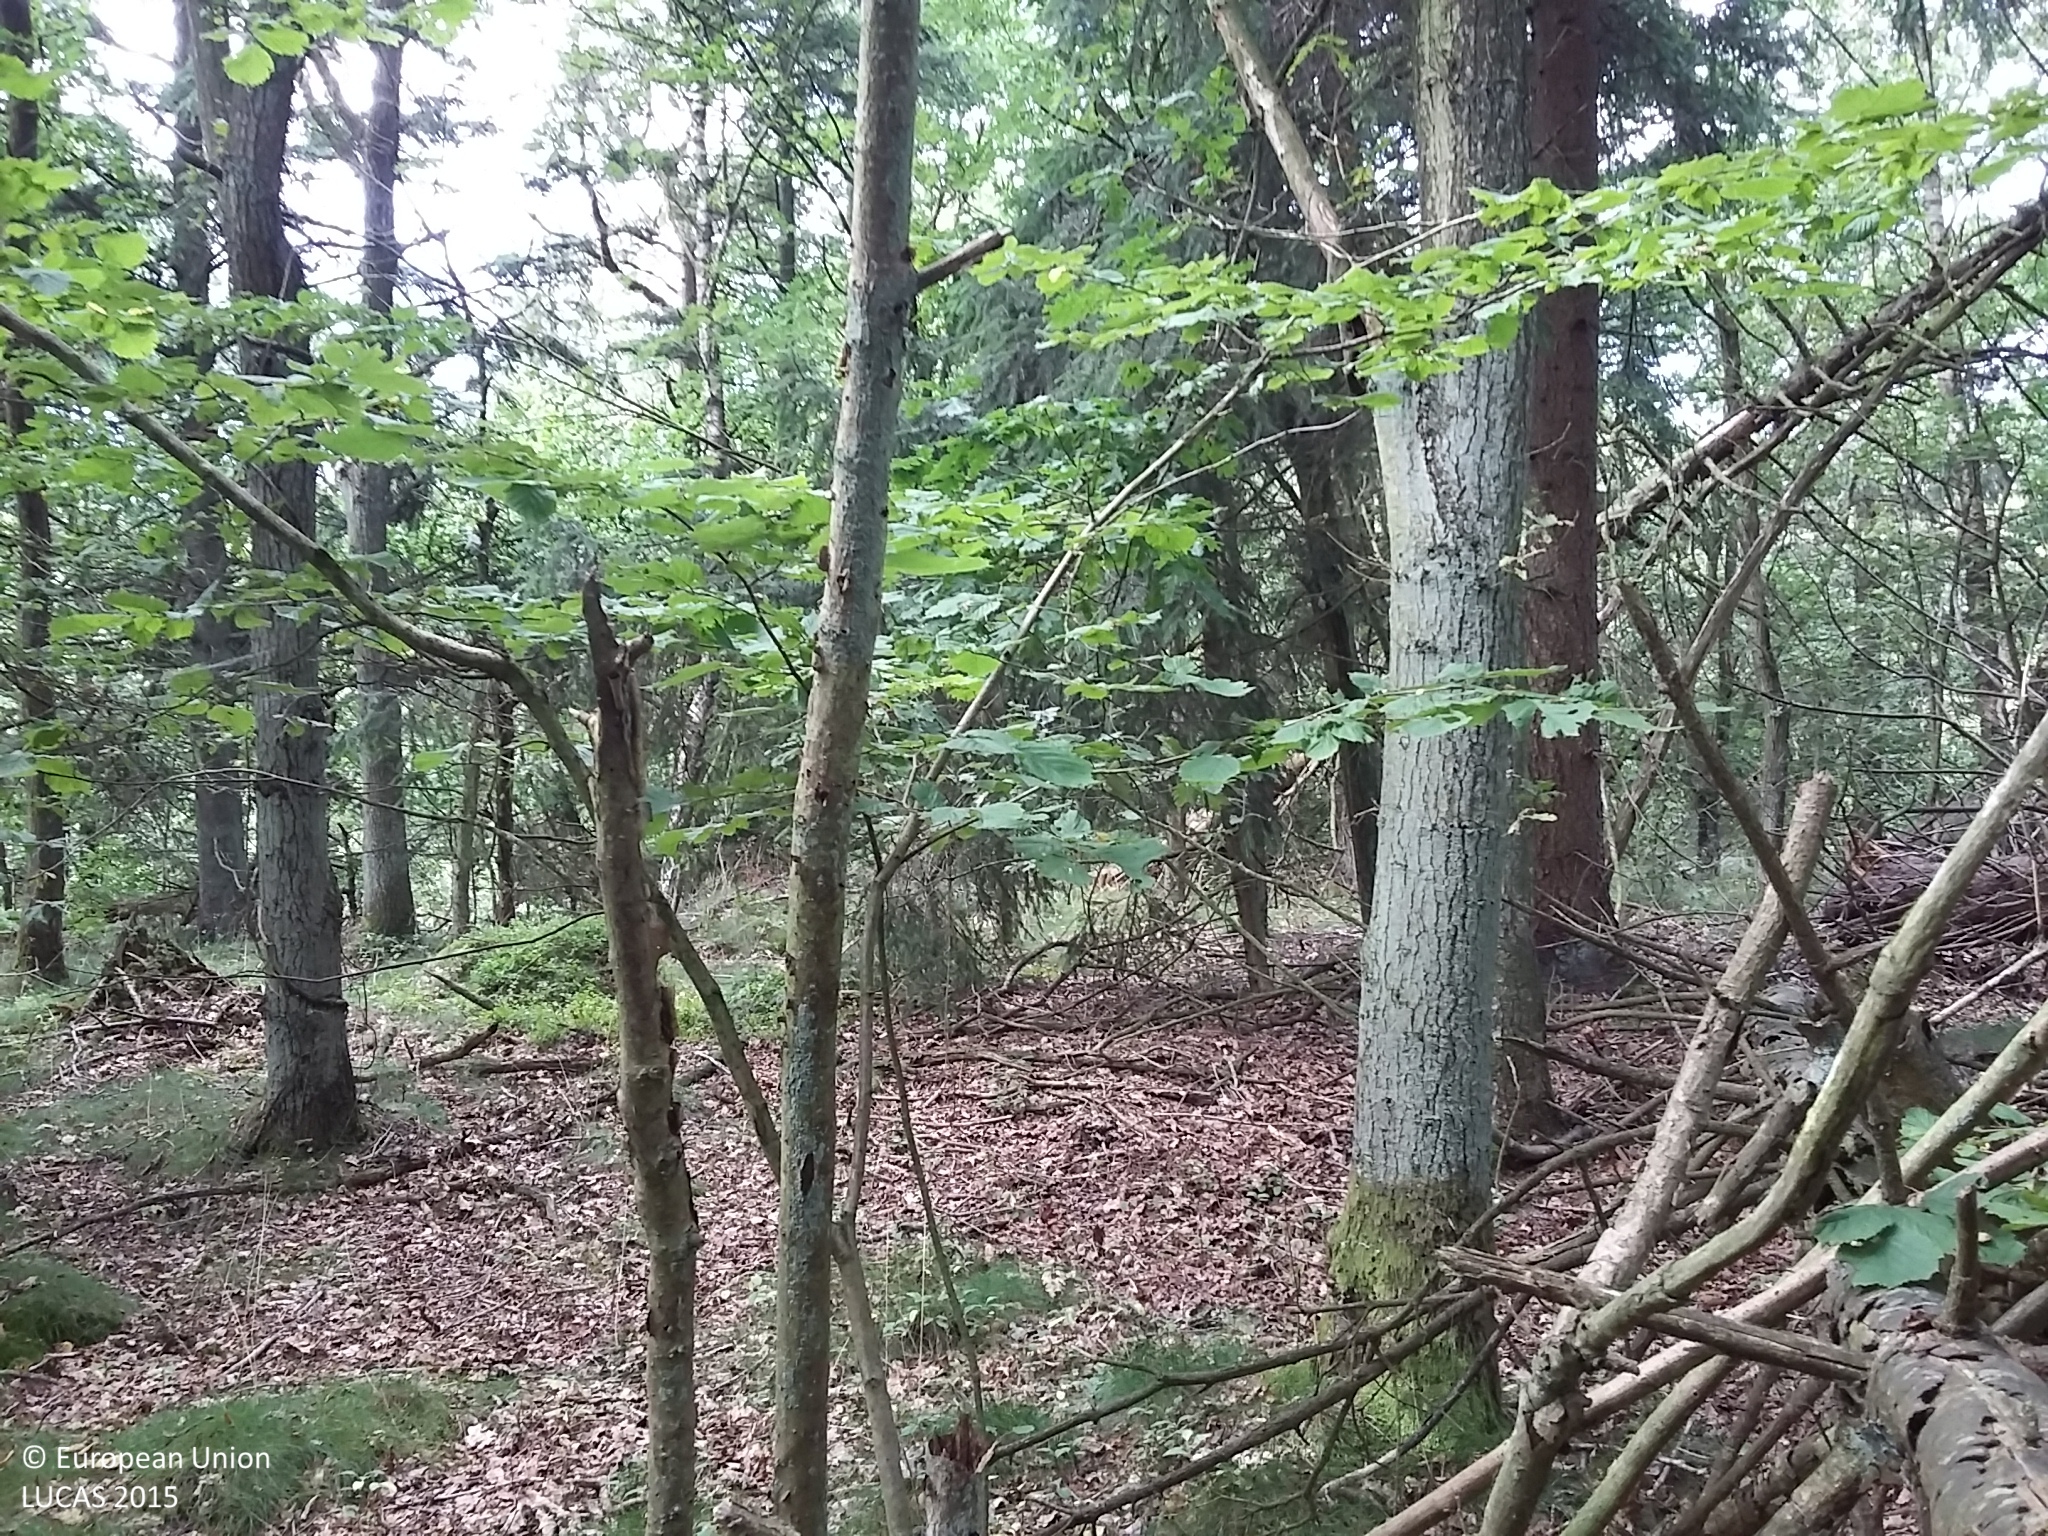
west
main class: Woodland
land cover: Other mixed woodland
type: hemiboreal forest and nemoral coniferous forest and mixed broadleaved-coniferous forest
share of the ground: > 75 %
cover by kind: coniferous forest trees 60 %, broadleaved forest trees 25 %, herbaceous plants 10 %, lichens and mosses 5 %
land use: Semi-natural and natural areas not in use
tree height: > 5 m
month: August
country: DK
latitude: 55.2529
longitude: 14.7667
